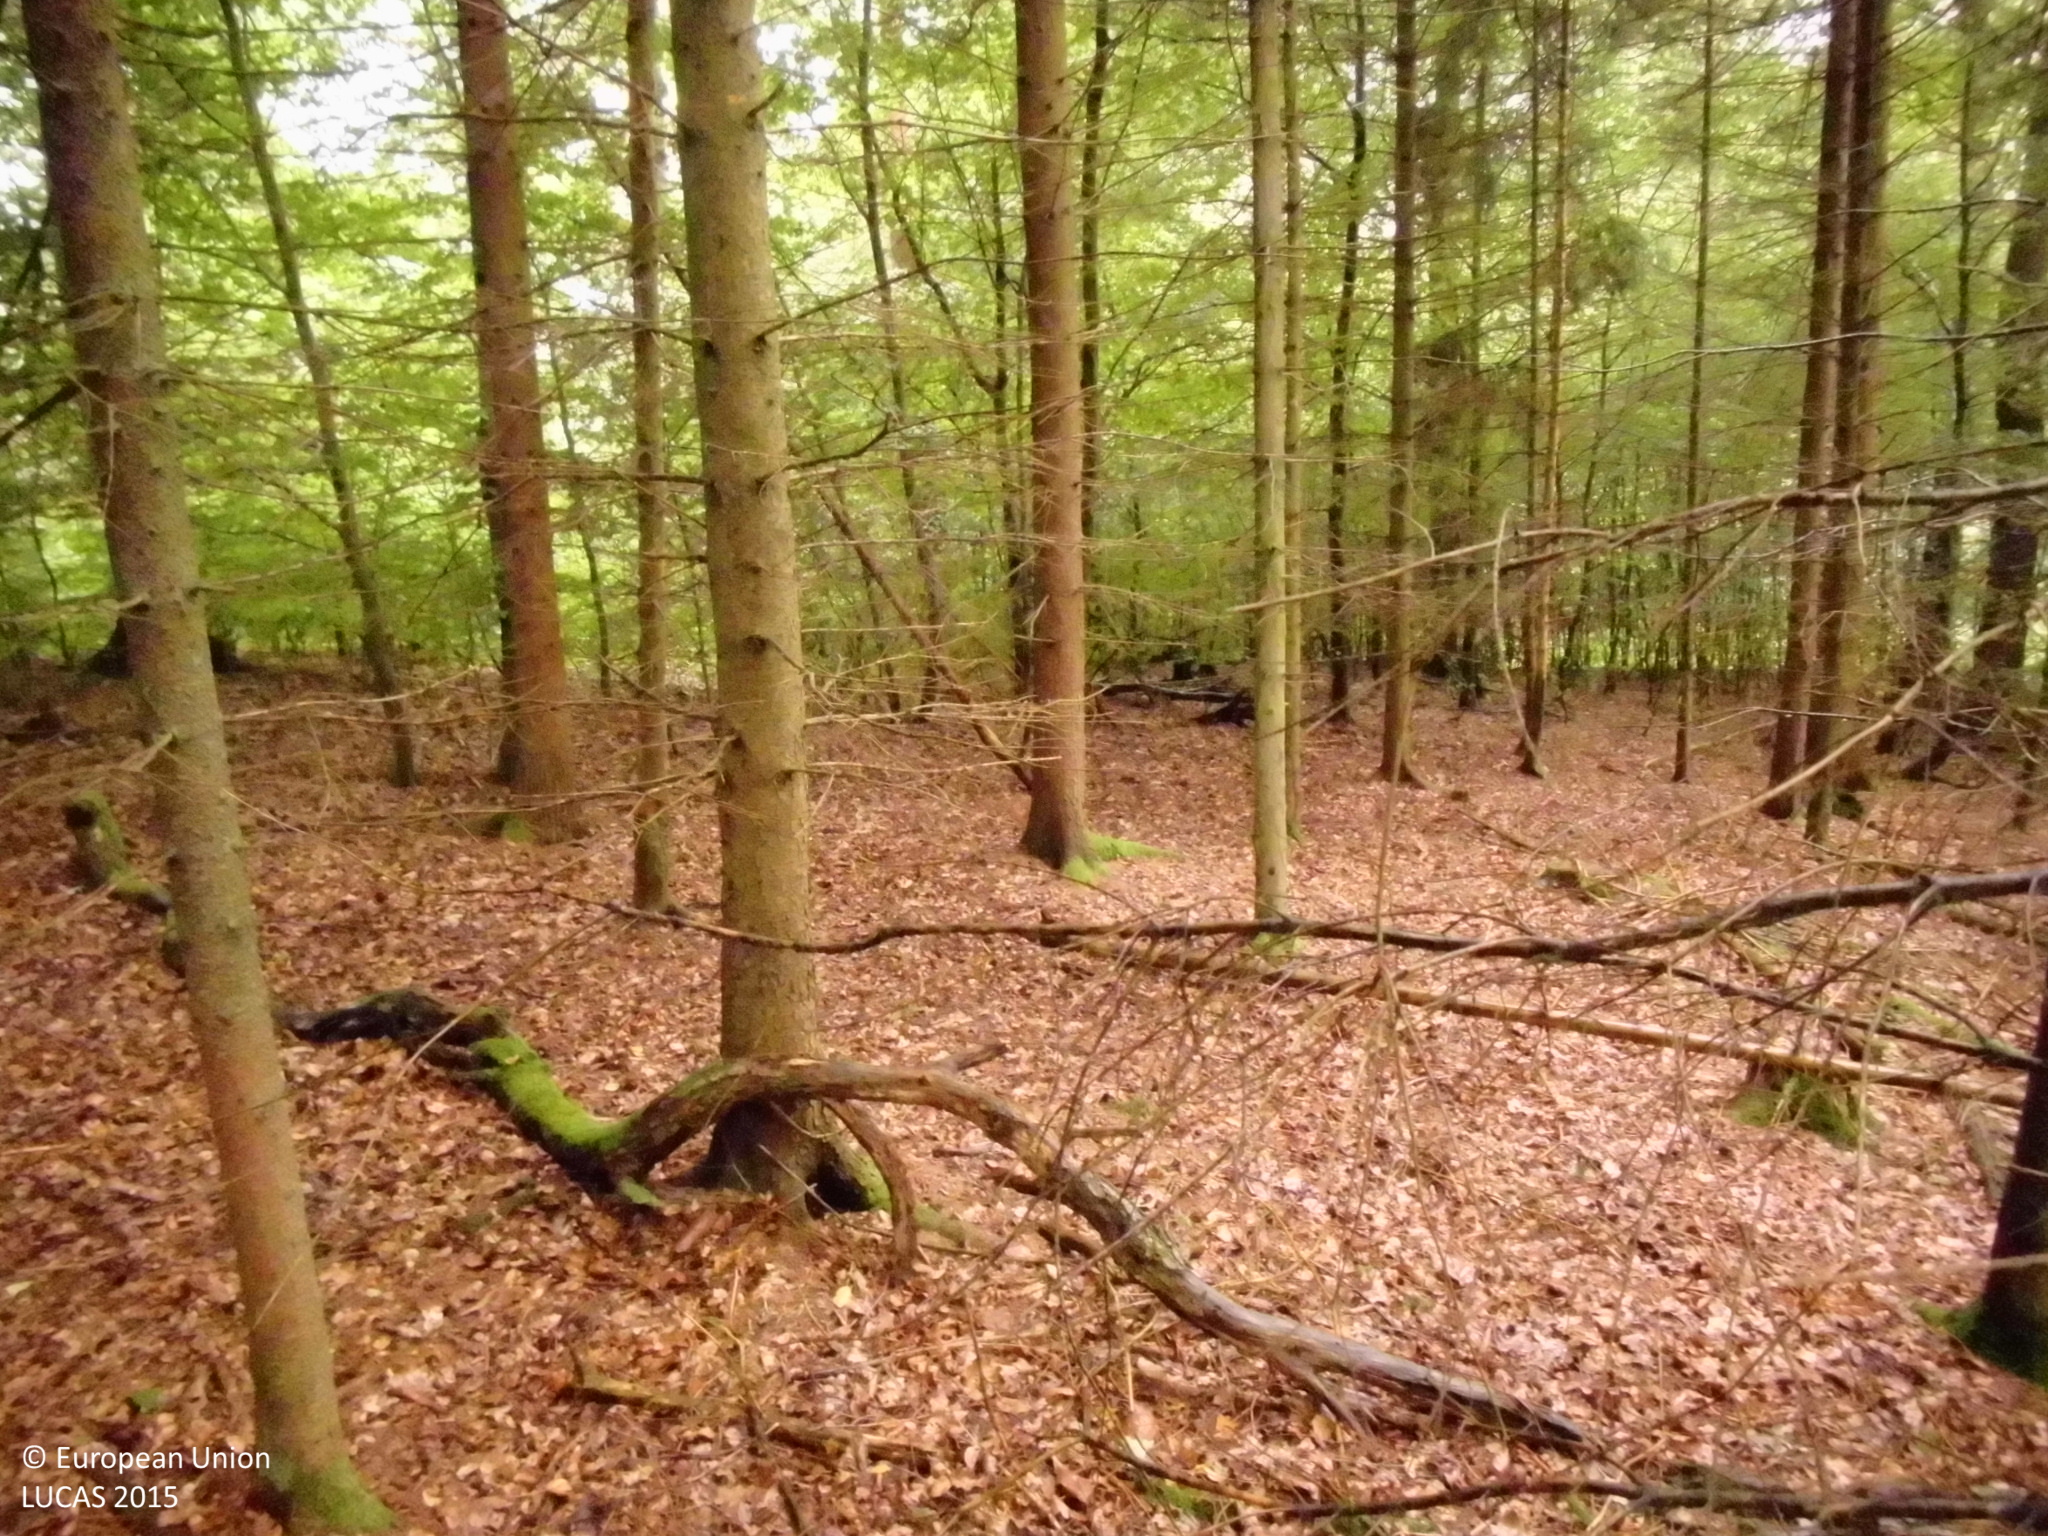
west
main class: Woodland
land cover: Broadleaved woodland
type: mesophytic deciduous forest
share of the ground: > 75 %
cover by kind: broadleaved forest trees 100 %
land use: Forestry
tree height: > 5 m
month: September
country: DE
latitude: 50.6239
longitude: 7.4700
